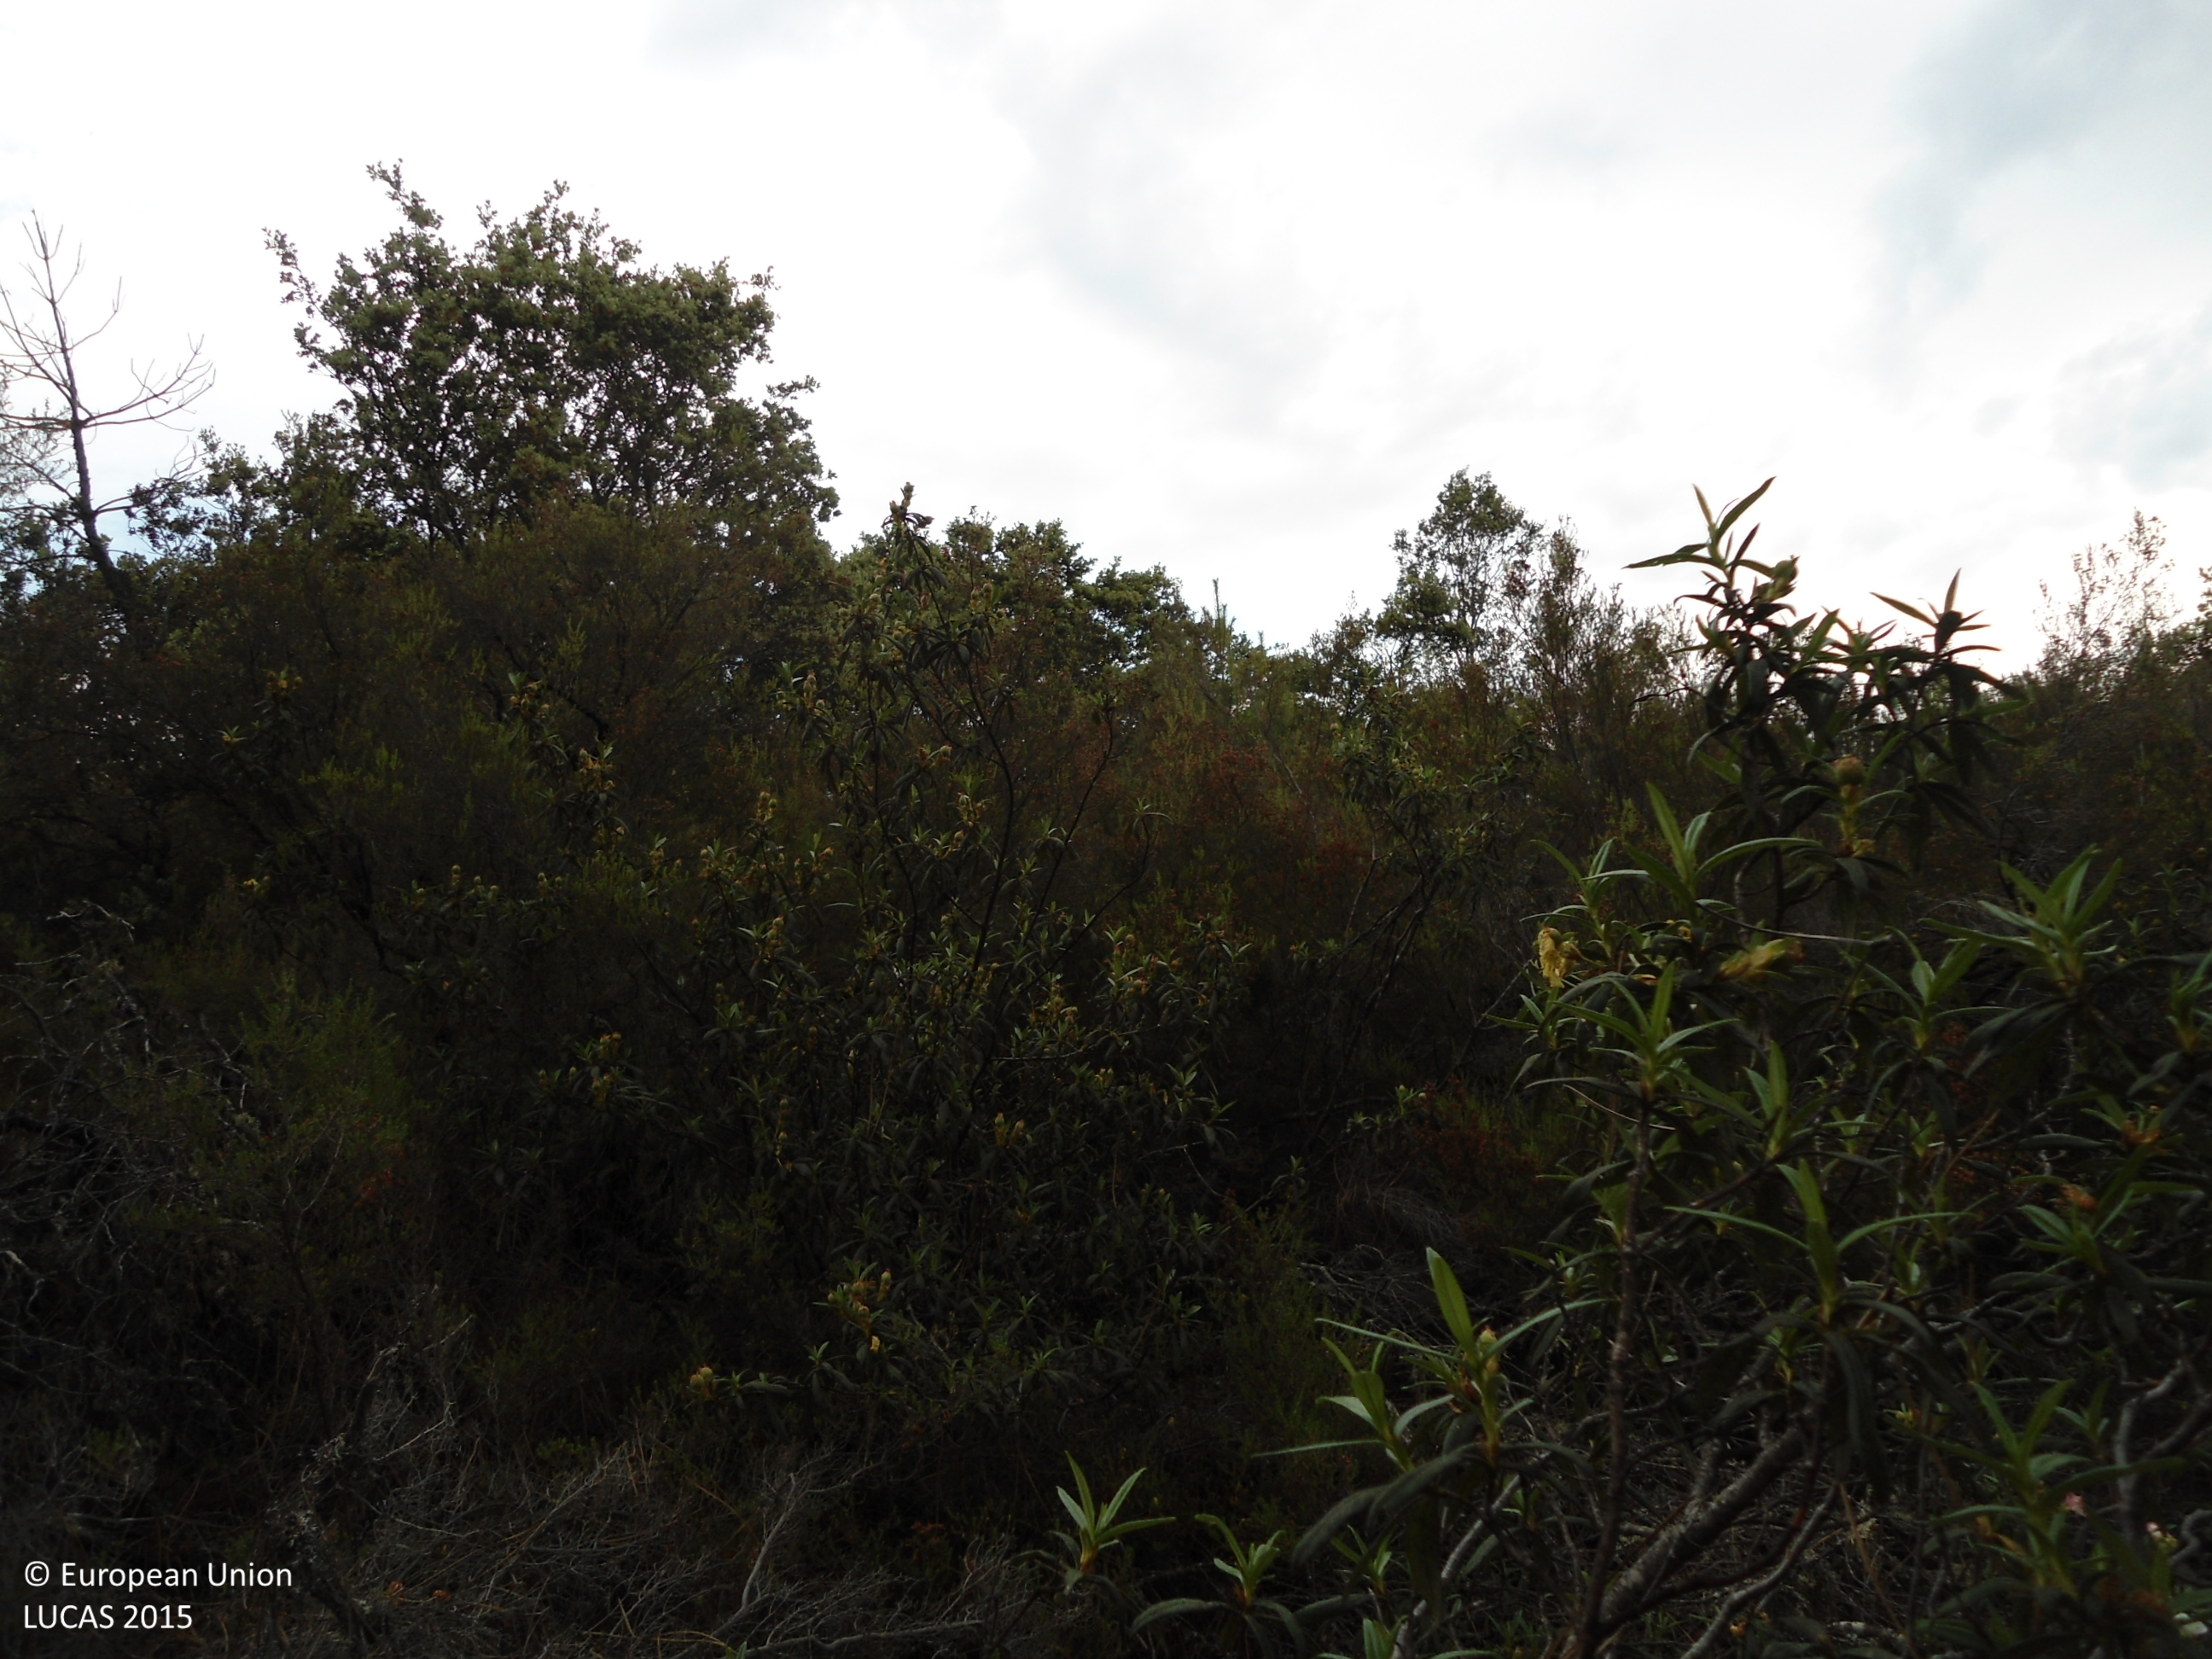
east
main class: Woodland
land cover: Pine dominated mixed woodland
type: coniferous forest of the mediterranean region
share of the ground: > 75 %
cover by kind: coniferous forest trees 65 %, broadleaved forest trees 25 %, shrubs 10 %
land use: Forestry
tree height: > 5 m
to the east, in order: Pine dominated mixed woodland; Shrubland with sparse tree cover; Broadleaved woodland; Shrubland with sparse tree cover; Rocks and stones; Shrubland with sparse tree cover; Pine dominated coniferous woodland
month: June
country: ES
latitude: 41.8751
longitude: -6.1867
